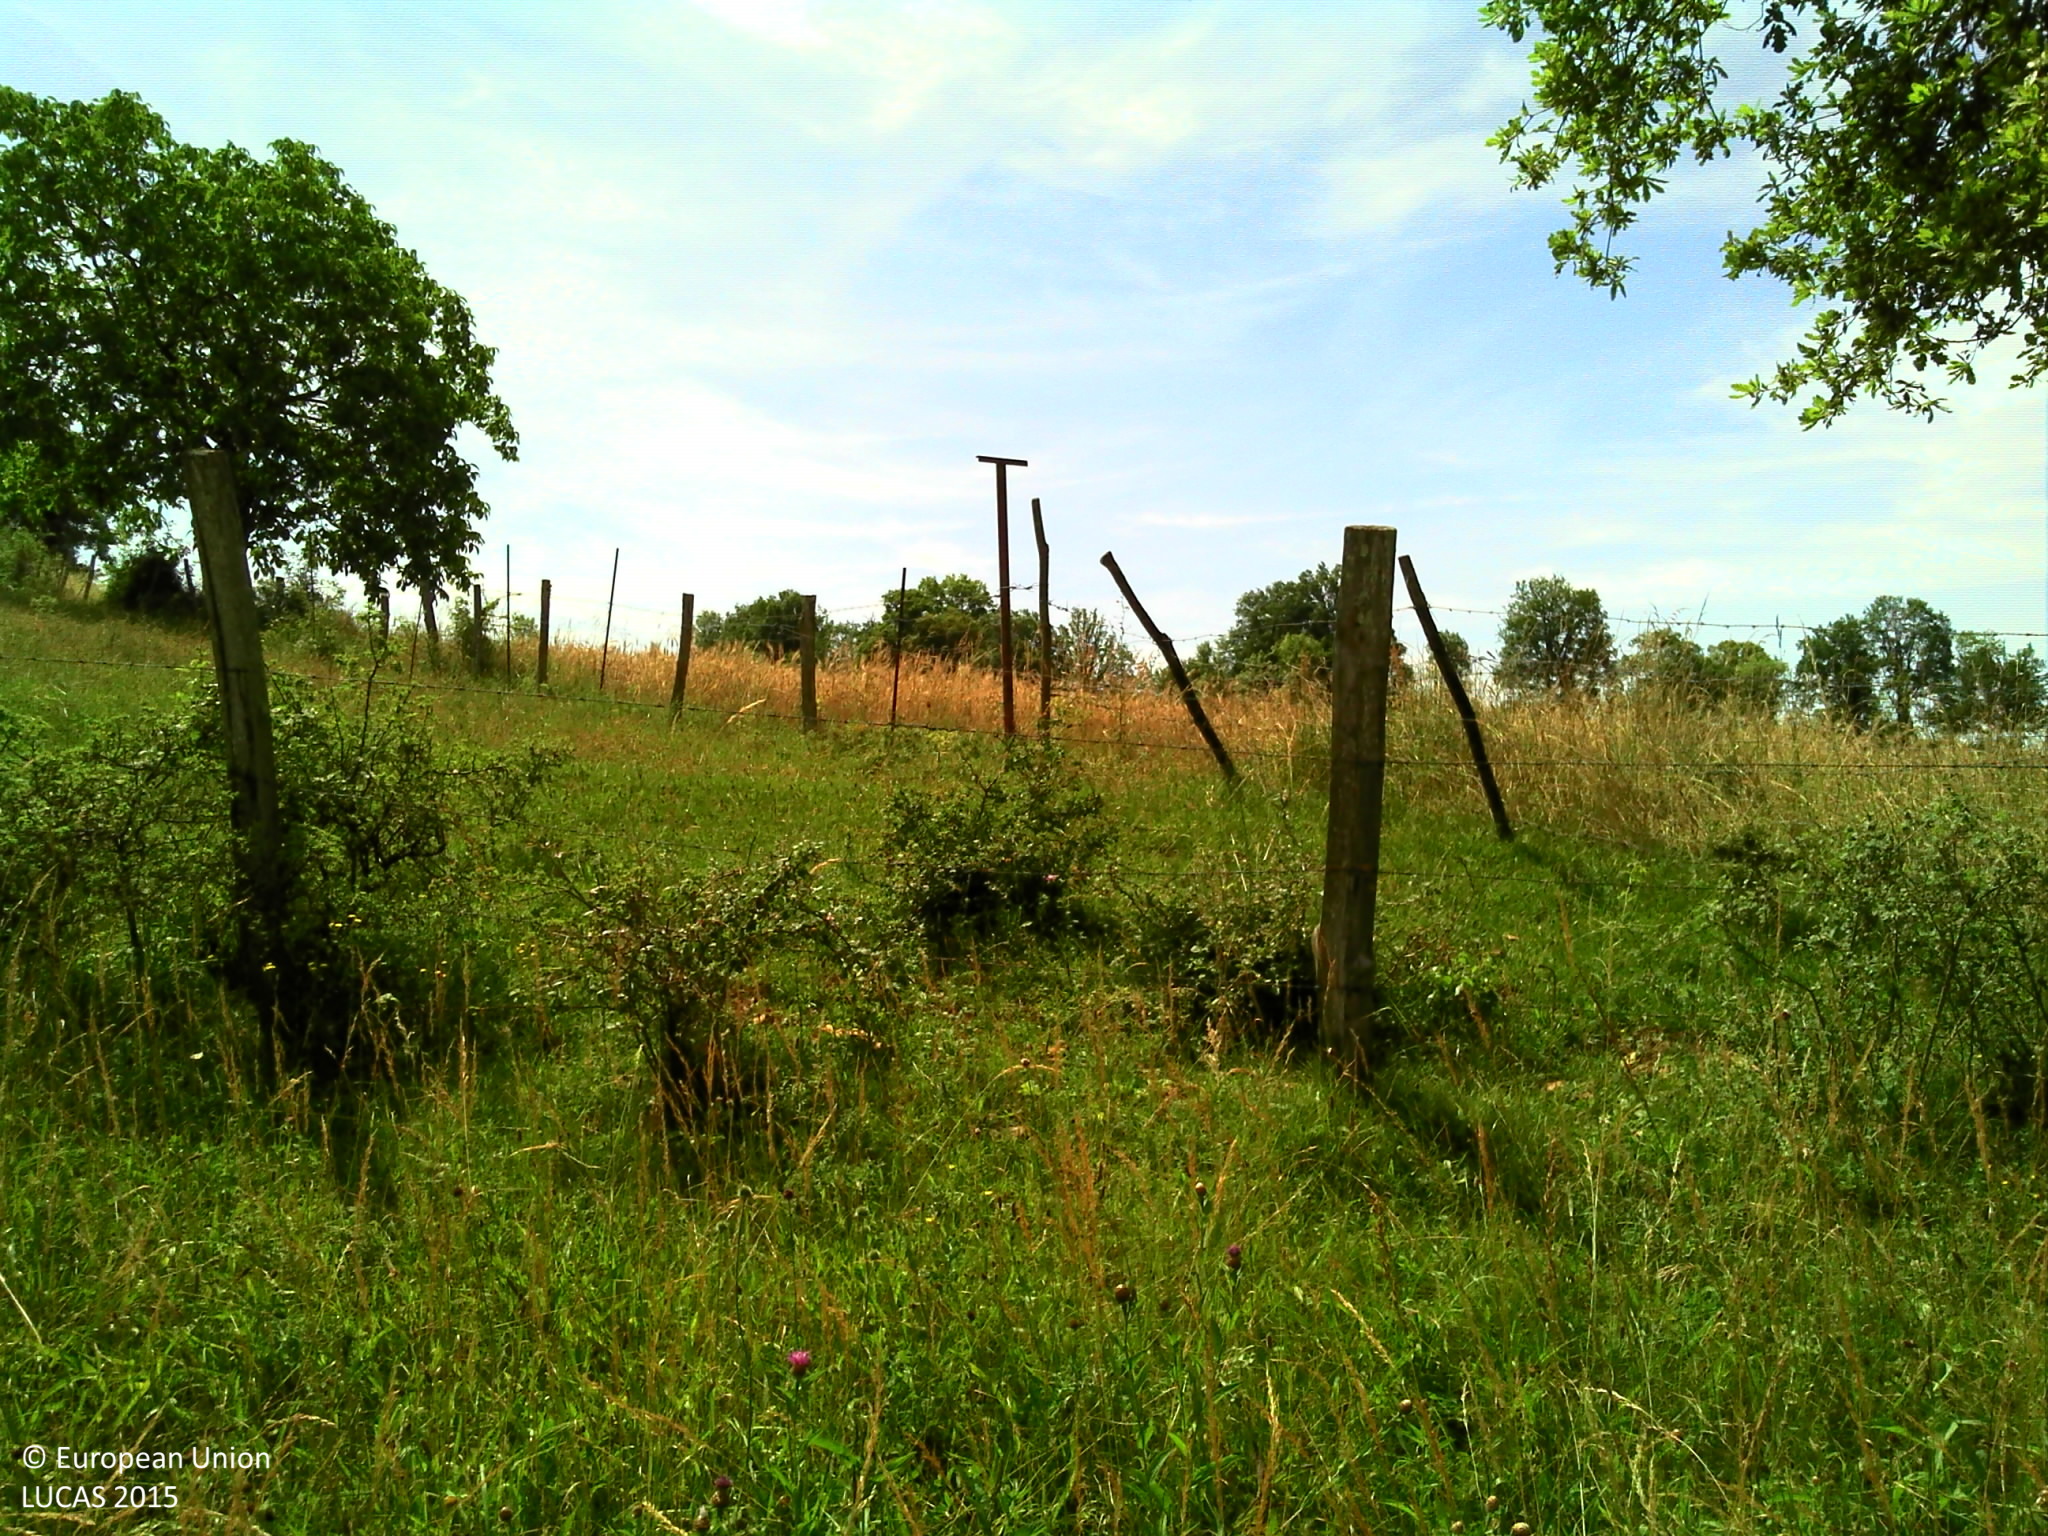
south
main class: Grassland
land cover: Grassland with sparse tree/shrub cover
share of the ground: > 75 %
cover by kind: herbaceous plants 95 %, broadleaved forest trees 5 %
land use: Agriculture (excluding fallow land and kitchen gardens)
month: June
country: FR
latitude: 44.5312
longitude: 2.0098
